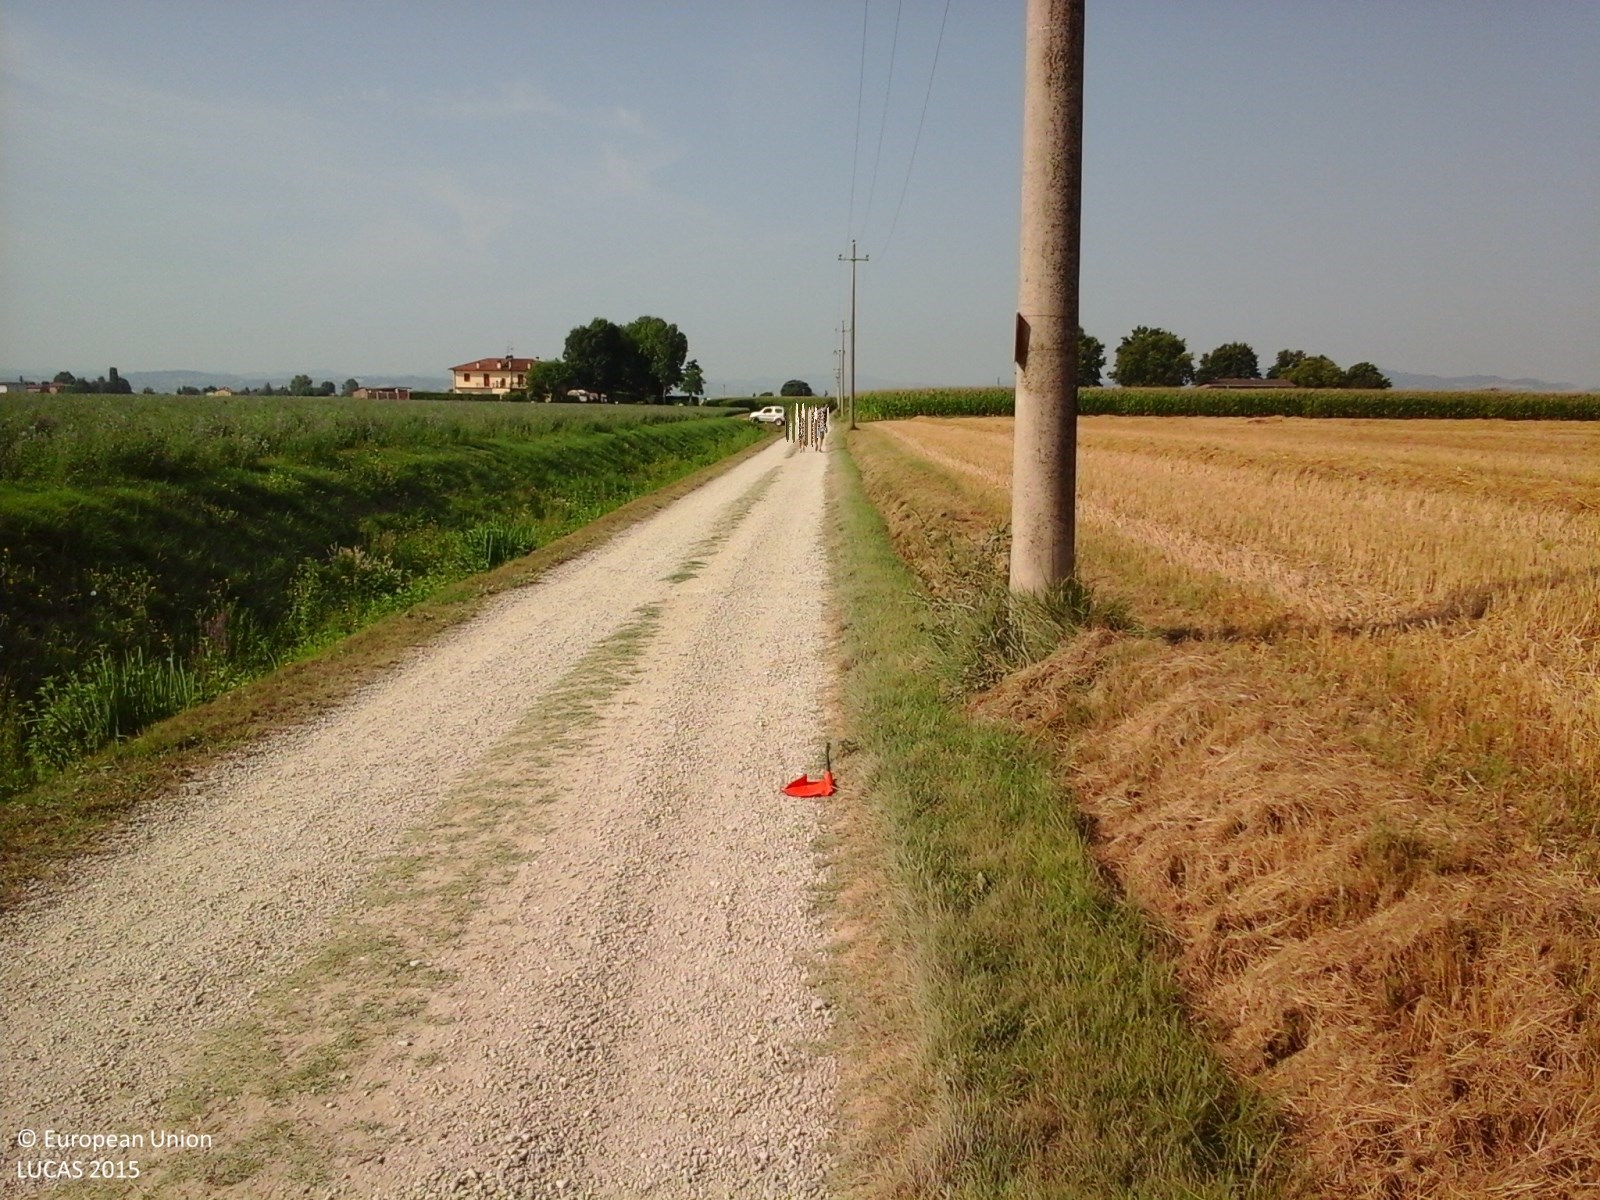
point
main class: Cropland
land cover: Barley
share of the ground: > 75 %
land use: Agriculture (excluding fallow land and kitchen gardens)
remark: Harvested field
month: July
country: IT
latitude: 44.4638
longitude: 11.6430
